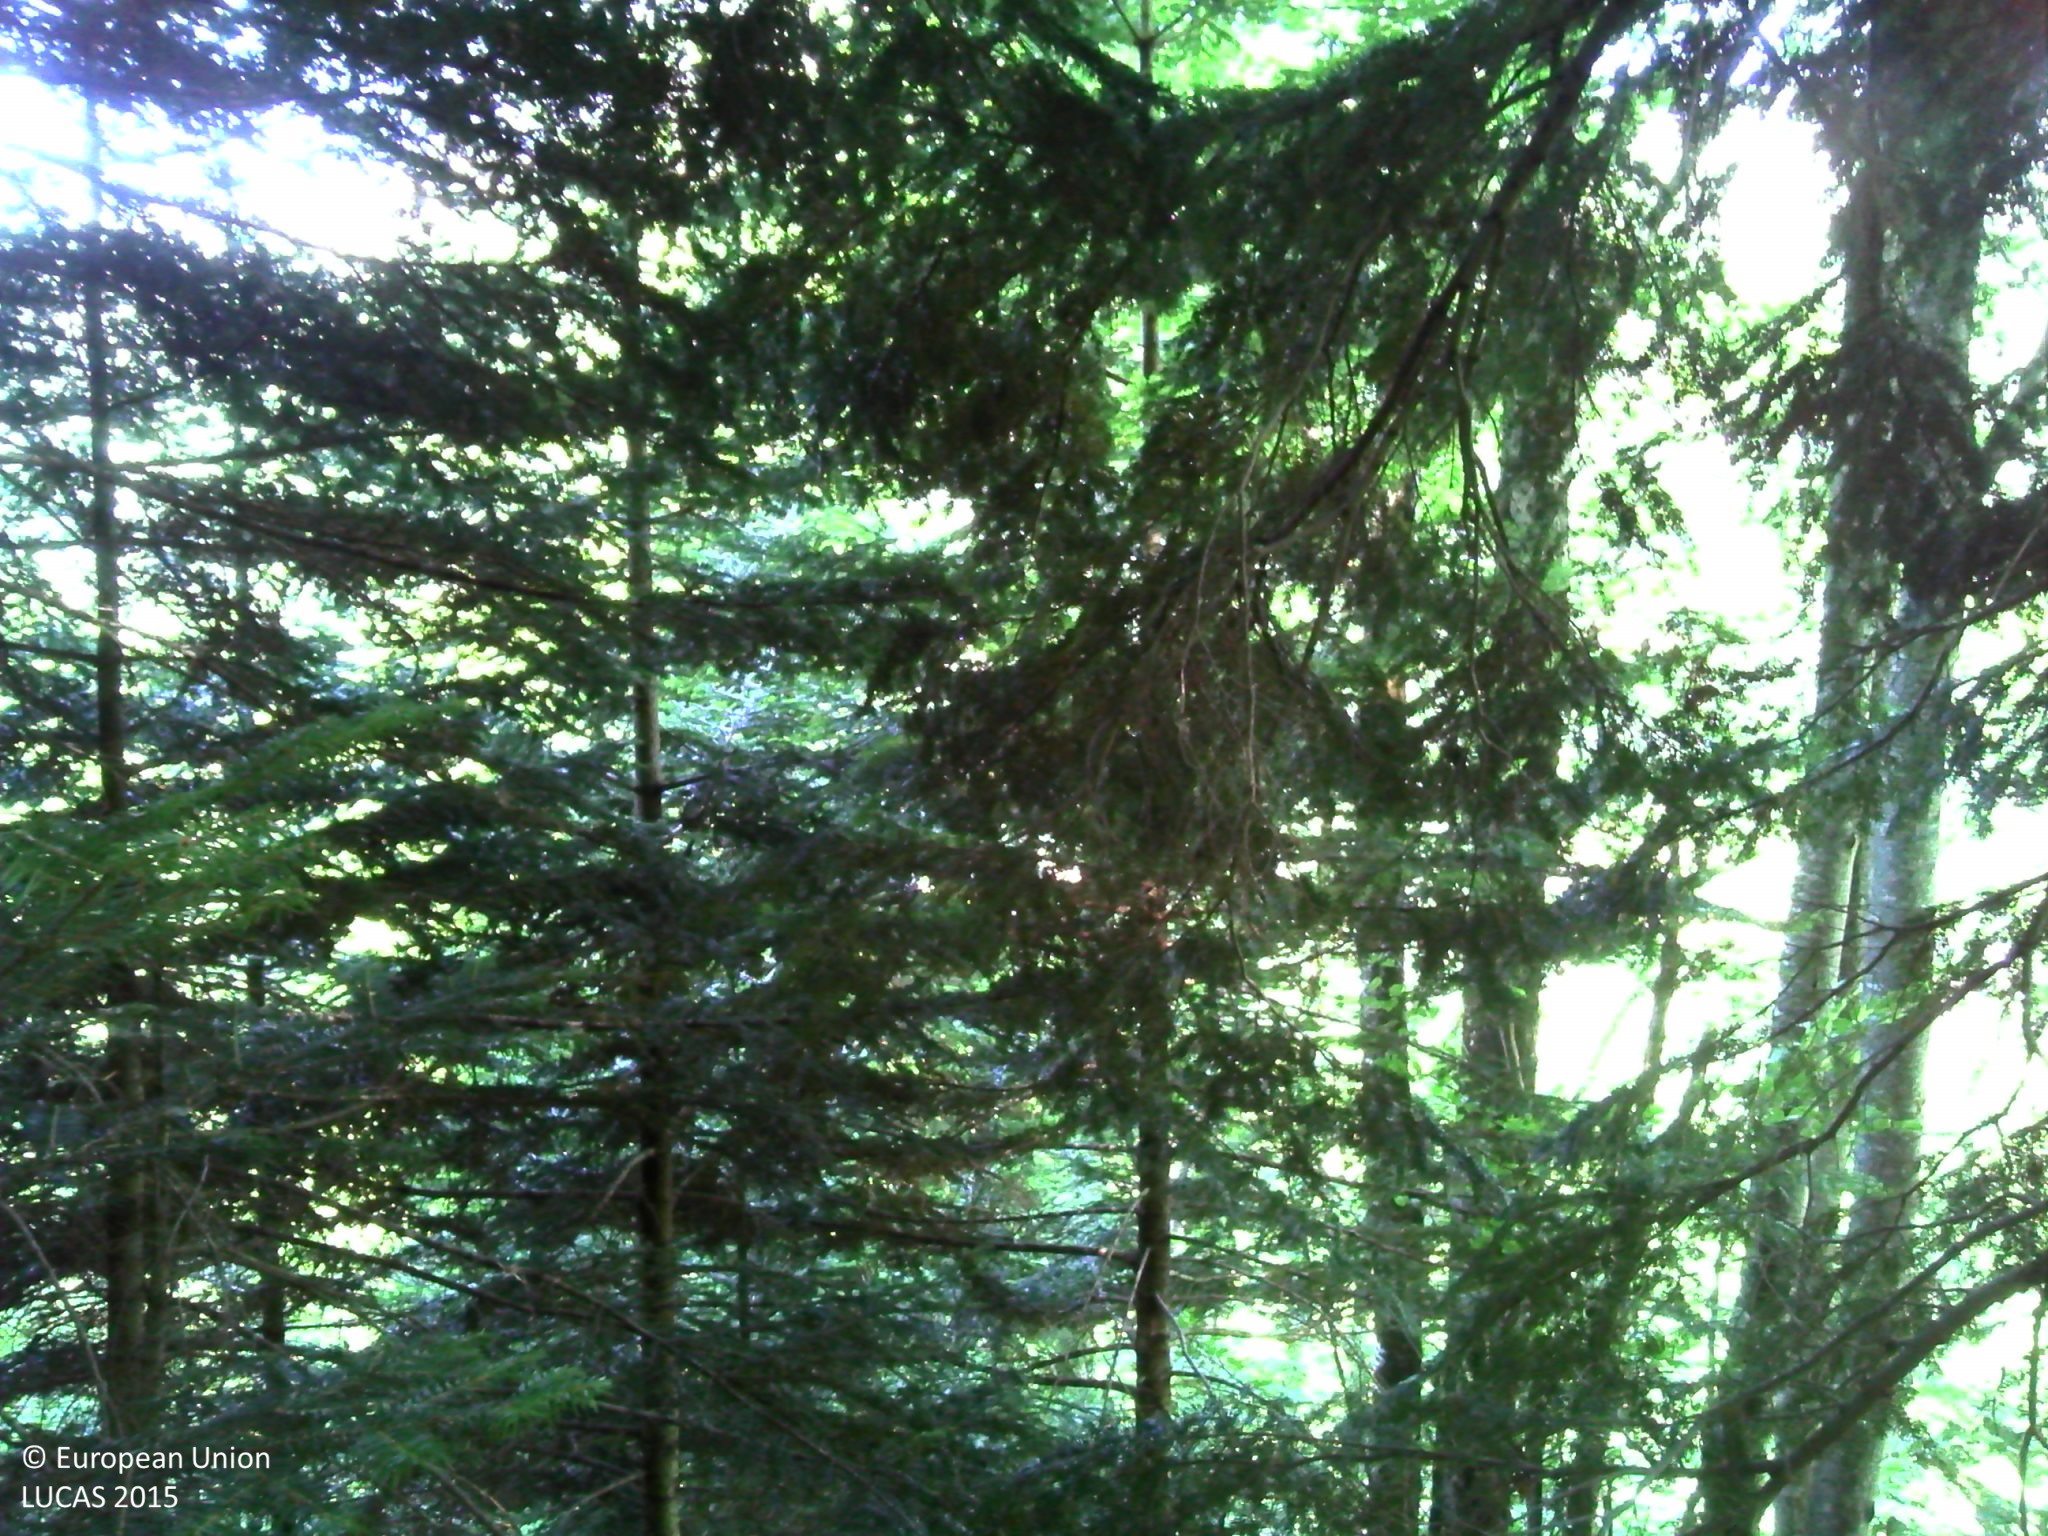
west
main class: Woodland
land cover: Other mixed woodland
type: mountainous beech forest
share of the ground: > 75 %
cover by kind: broadleaved forest trees 75 %, coniferous forest trees 25 %
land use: Forestry
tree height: > 5 m
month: July
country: FR
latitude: 42.8930
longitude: -0.1044
